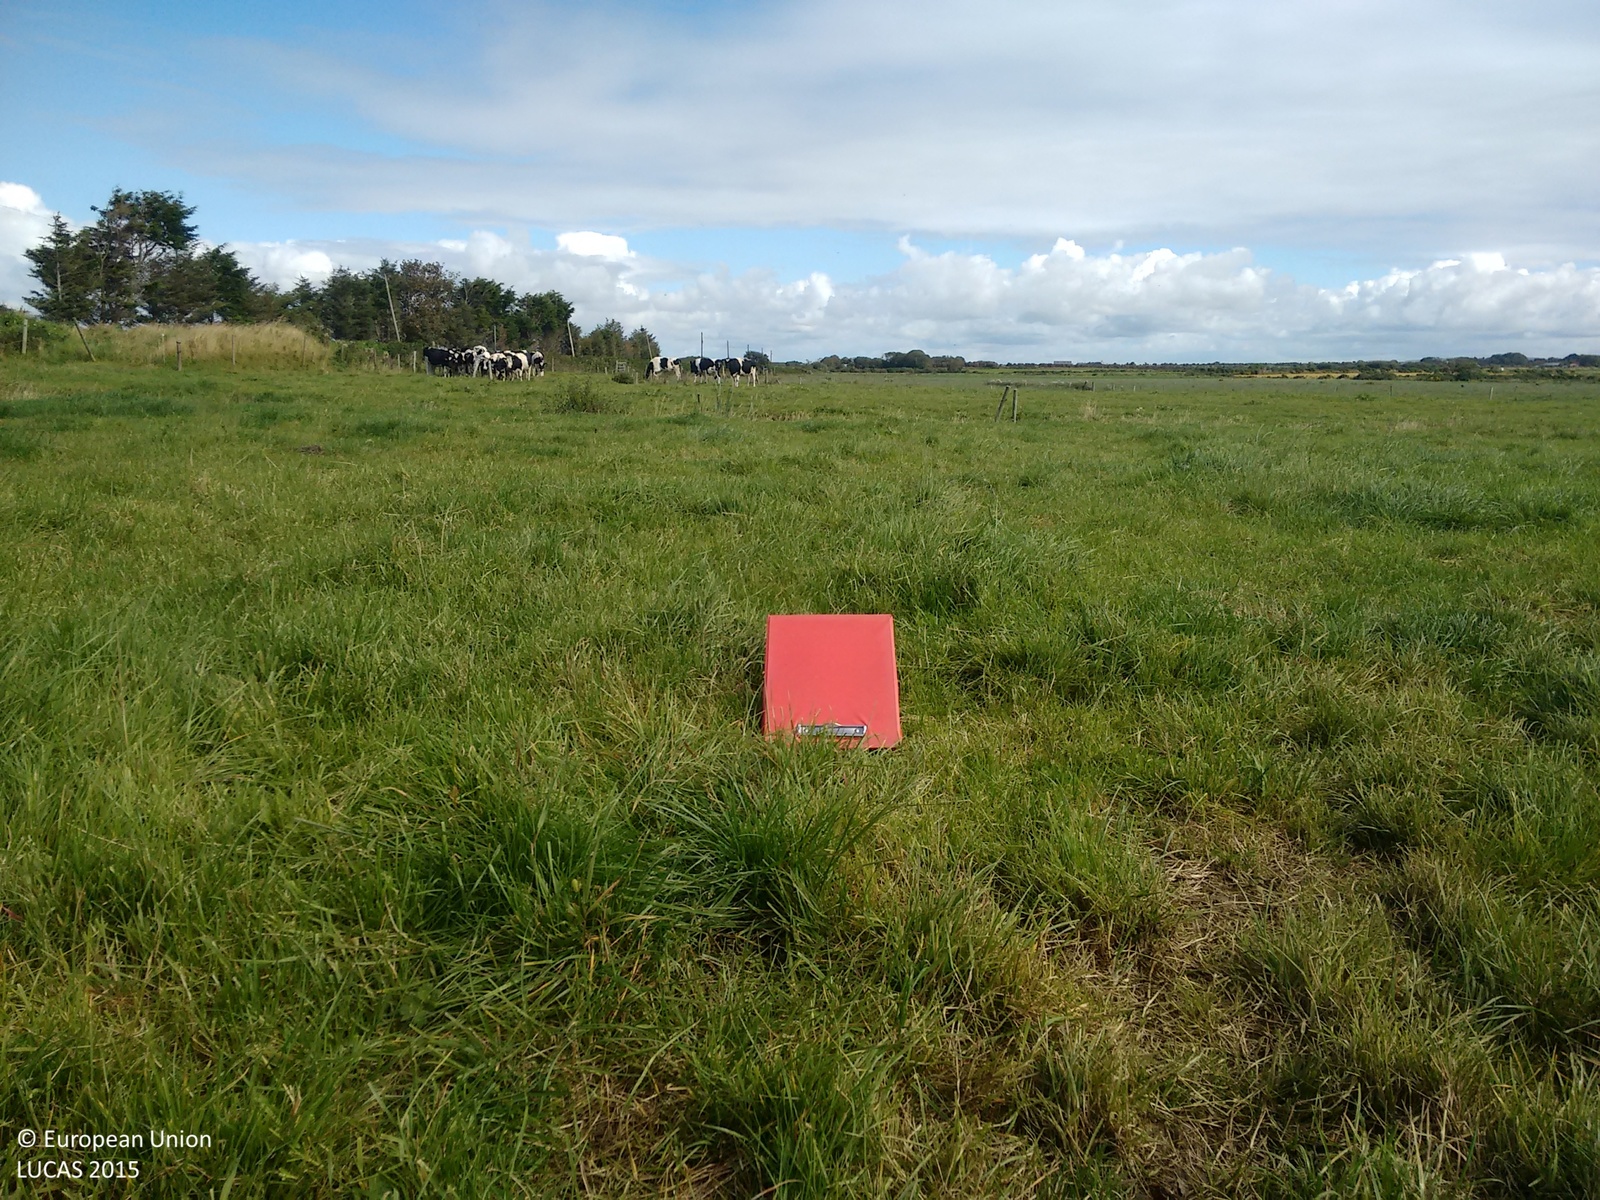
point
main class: Grassland
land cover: Grassland without tree/shrub cover
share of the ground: > 75 %
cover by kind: herbaceous plants 100 %
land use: Agriculture (excluding fallow land and kitchen gardens)
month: September
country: IE
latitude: 52.3950
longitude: -9.7752
